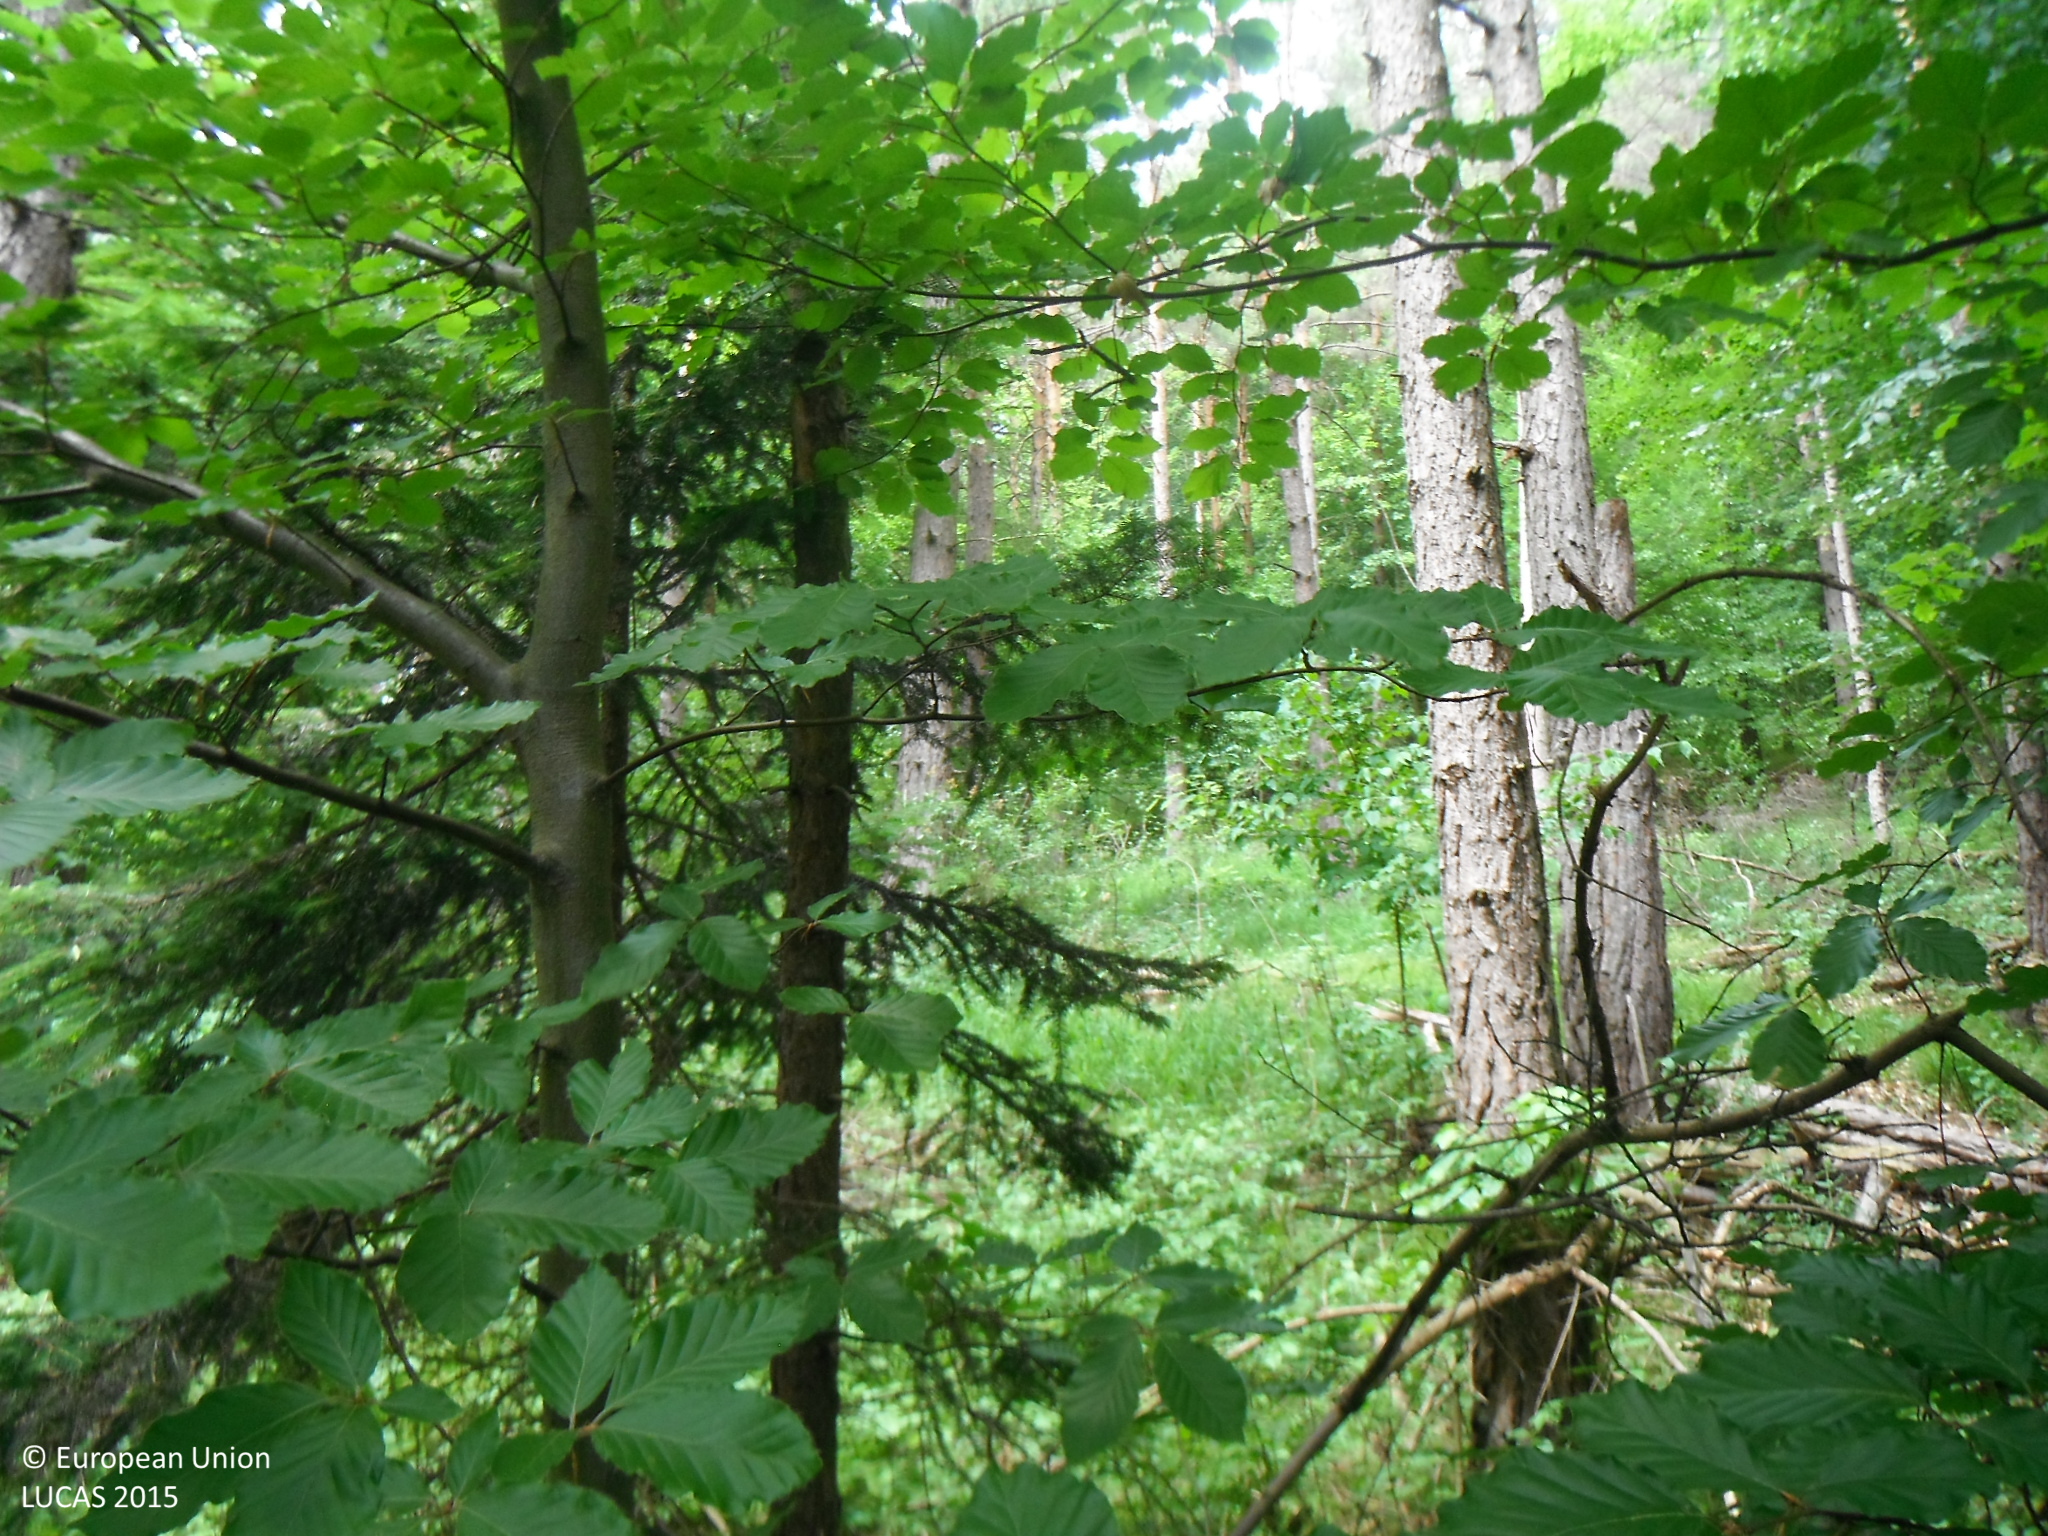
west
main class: Woodland
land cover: Pine dominated coniferous woodland
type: alpine coniferous forest
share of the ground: > 75 %
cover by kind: coniferous forest trees 80 %, herbaceous plants 10 %, shrubs 5 %, unconsolidated bare surface 5 %
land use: Forestry
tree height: > 5 m
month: July
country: SK
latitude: 49.0672
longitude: 18.5454
